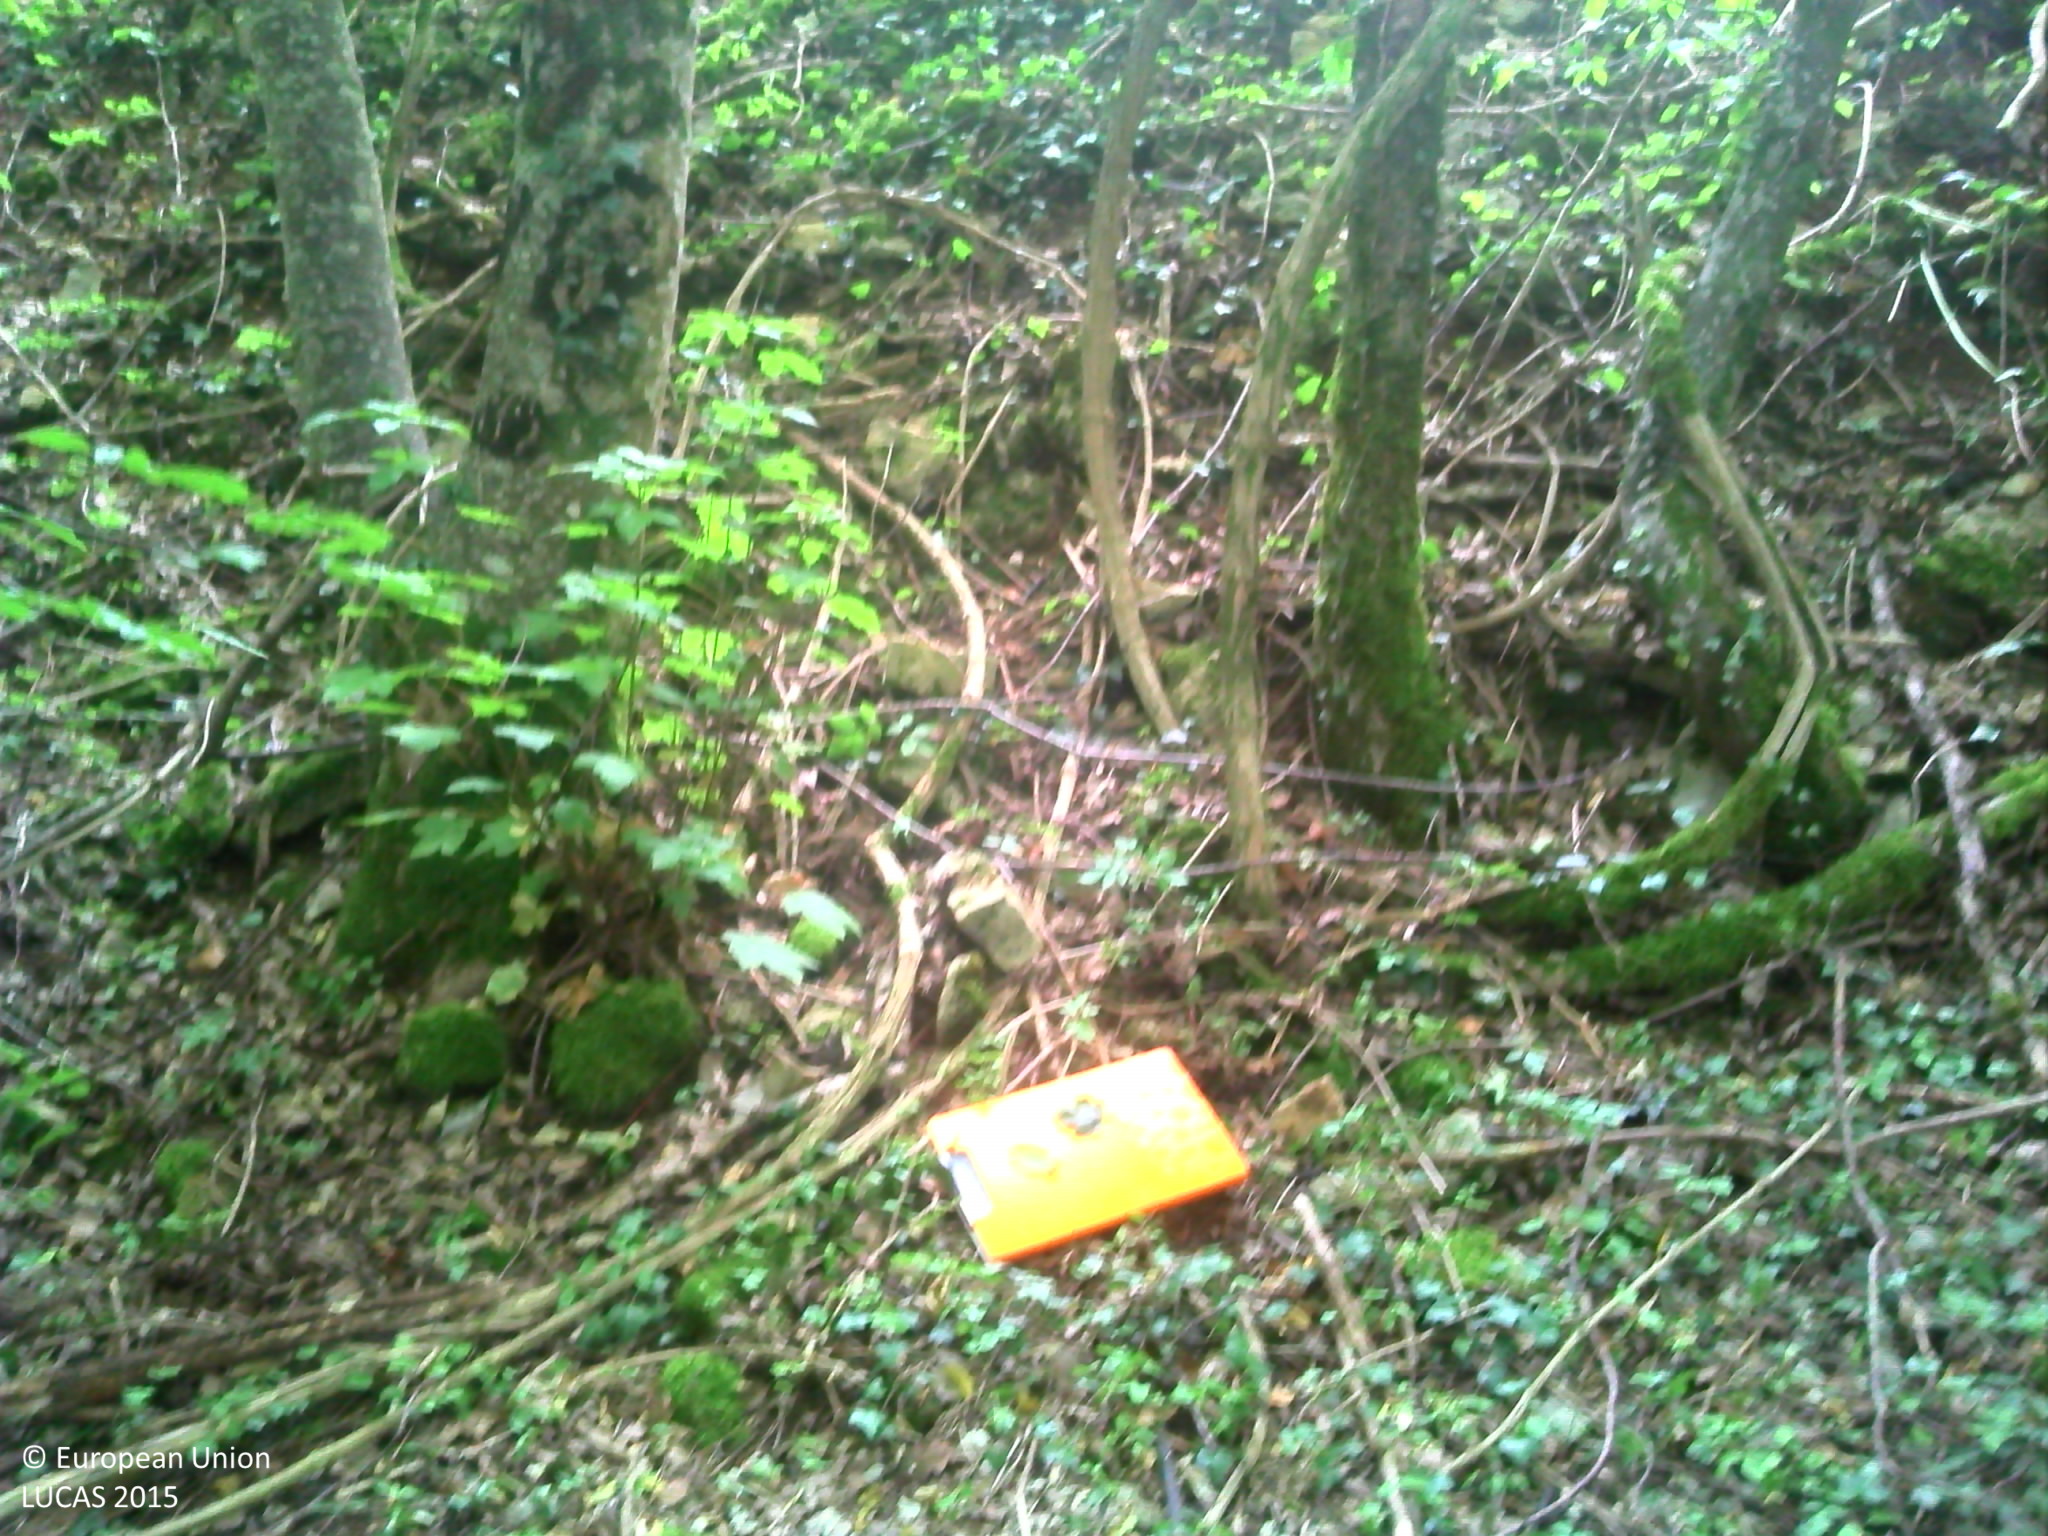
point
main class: Woodland
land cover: Broadleaved woodland
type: mesophytic deciduous forest
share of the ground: > 75 %
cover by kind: broadleaved forest trees 85 %, herbaceous plants 10 %, lichens and mosses 5 %
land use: Forestry
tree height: > 5 m
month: July
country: FR
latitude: 48.0810
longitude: 5.1534
